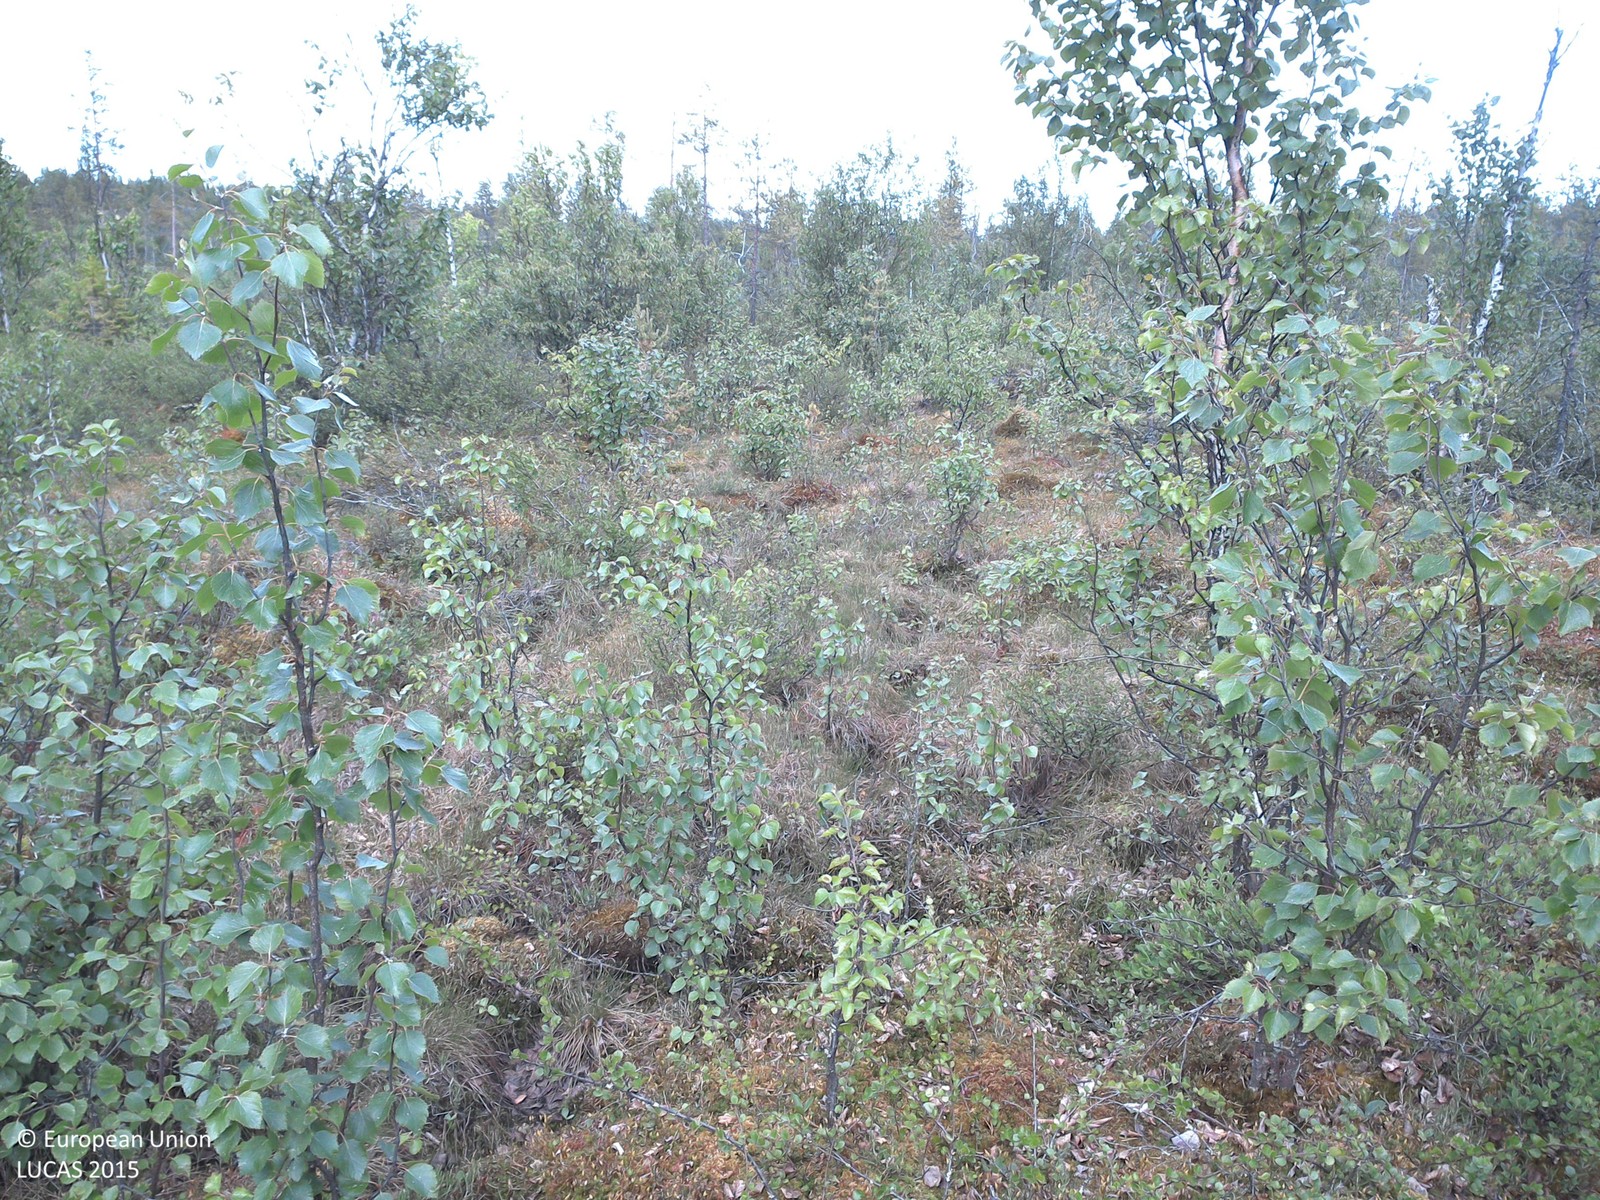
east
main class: Woodland
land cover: Other mixed woodland
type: boreal forest
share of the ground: 10 - 25 %
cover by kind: lichens and mosses 45 %, shrubs 35 %, coniferous forest trees 10 %, broadleaved forest trees 10 %
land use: Forestry
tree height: < 5 m
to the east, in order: Other mixed woodland; Ditches and canals; Other mixed woodland; Pine dominated mixed woodland; Ditches and canals; Pine dominated mixed woodland; Ditches and canals; Pine dominated mixed woodland; Groves; Pine dominated mixed woodland; Ditches and canals; Pine dominated mixed woodland; Ditches and canals; Pine dominated mixed woodland
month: July
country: SE
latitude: 67.2439
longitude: 23.2444
